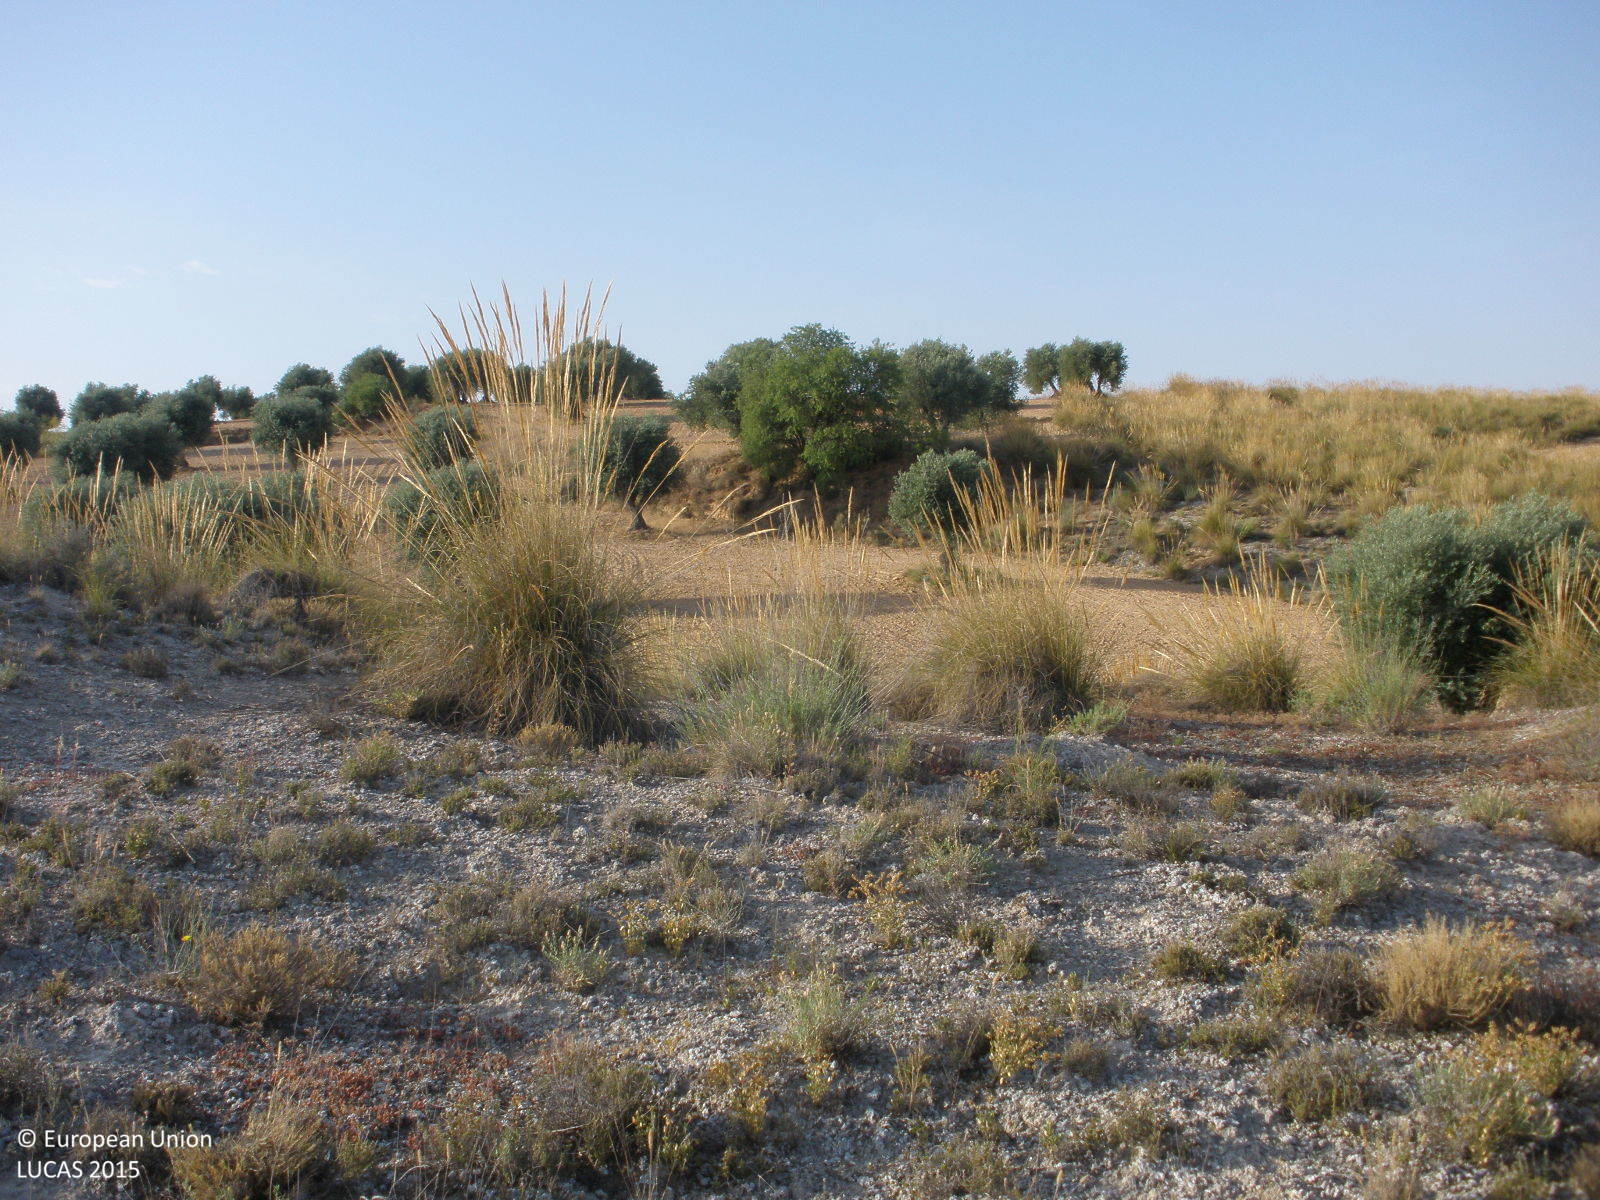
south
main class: Shrubland
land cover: Shrubland without tree cover
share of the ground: 25 - 50 %
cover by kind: shrubs 40 %, herbaceous plants 40 %, consolidated bare surface 20 %
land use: Semi-natural and natural areas not in use
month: July
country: ES
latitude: 40.0150
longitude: -3.4436
